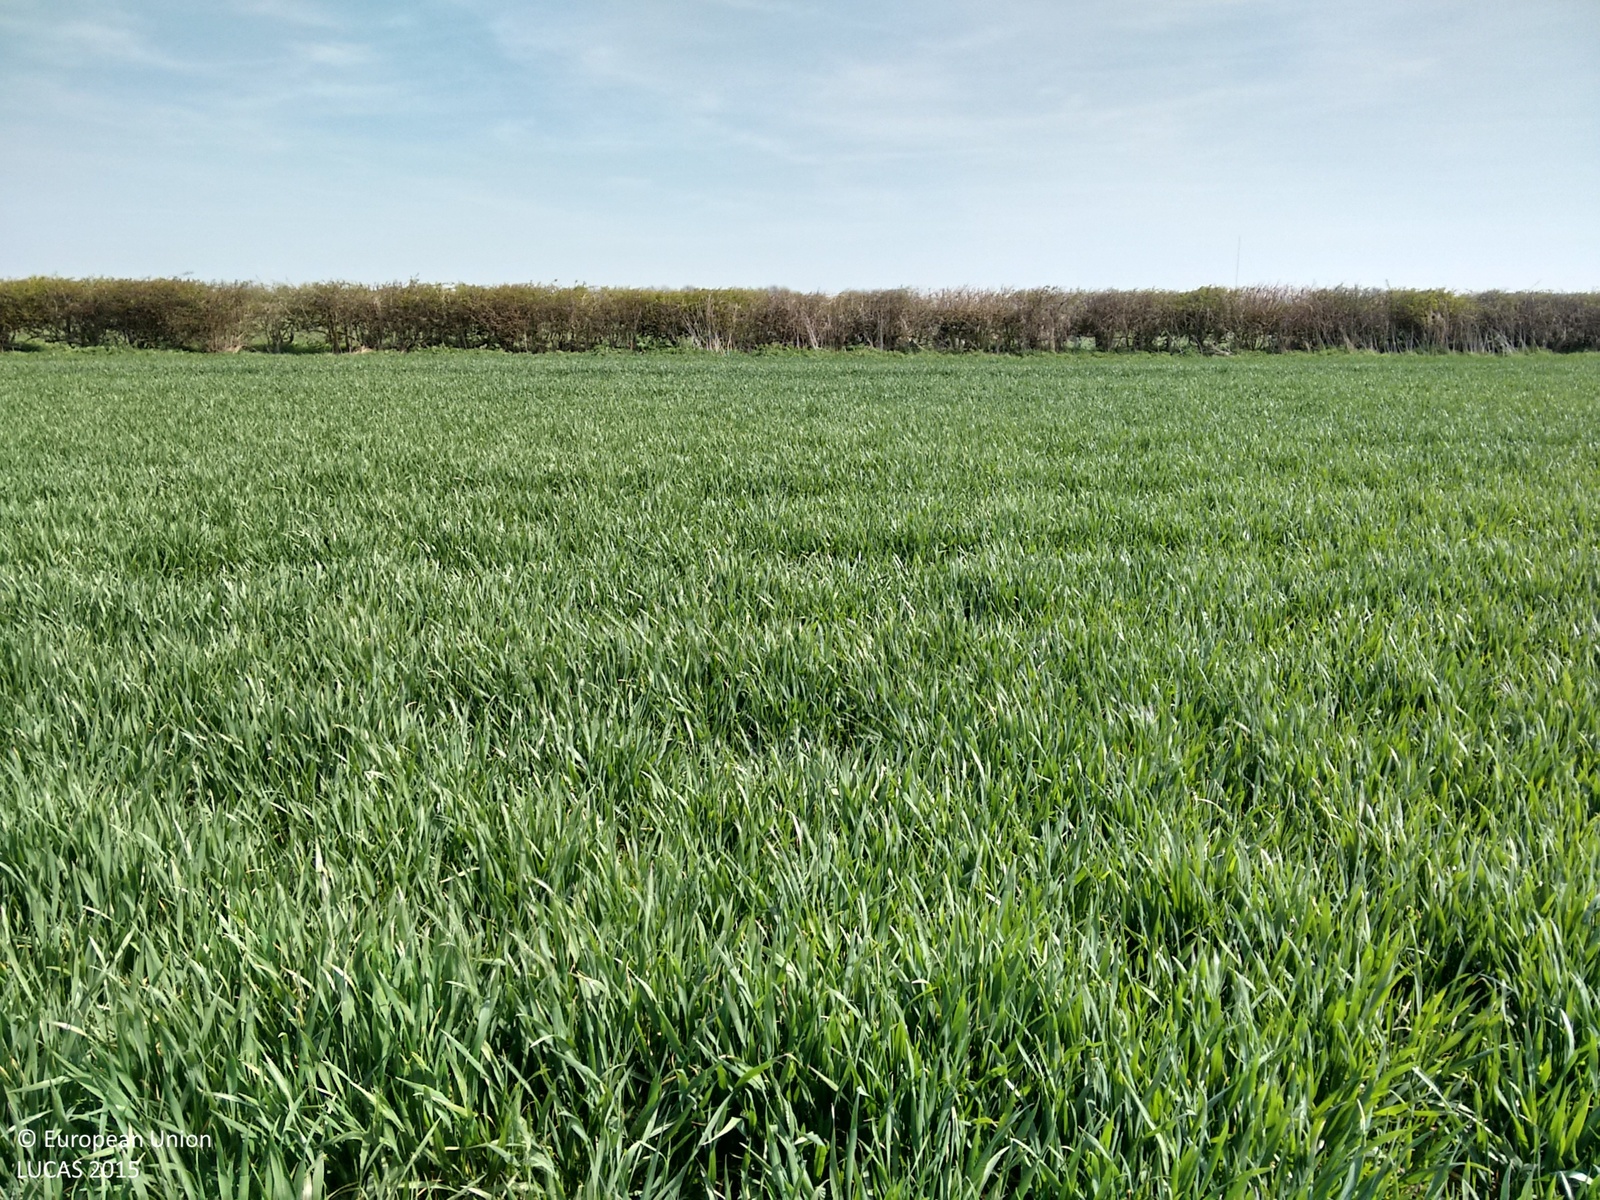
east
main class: Cropland
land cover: Barley
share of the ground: > 75 %
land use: Agriculture (excluding fallow land and kitchen gardens)
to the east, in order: Barley; Grass margins; Managed hedges; Grassland without tree/shrub cover
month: April
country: GB
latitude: 53.4360
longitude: -0.6818
